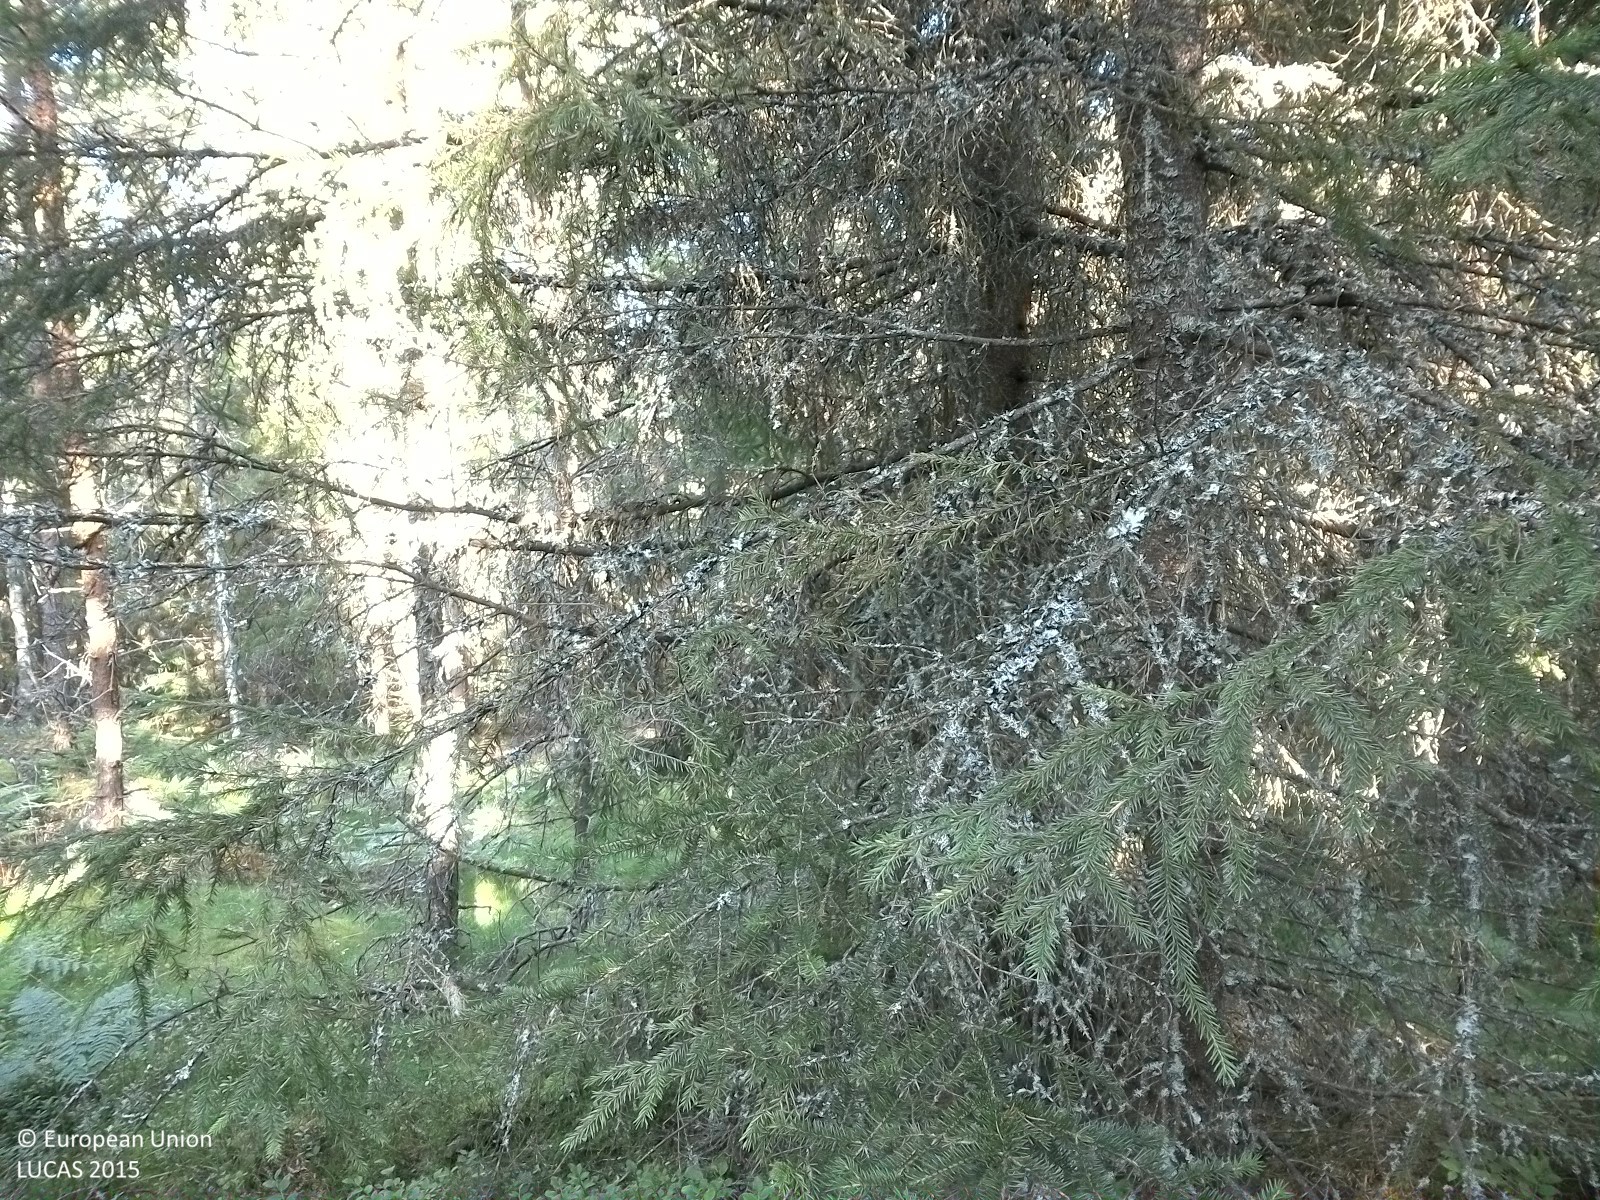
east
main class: Woodland
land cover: Other coniferous woodland
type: boreal forest
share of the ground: 25 - 50 %
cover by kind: herbaceous plants 45 %, coniferous forest trees 40 %, lichens and mosses 15 %
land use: Forestry
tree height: > 5 m
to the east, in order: Other coniferous woodland; Tracks; Spruce dominated coniferous woodland; Spruce dominated mixed woodland; Other coniferous woodland; Tracks; Spruce dominated coniferous woodland; Tracks; Pine dominated coniferous woodland; Tracks; Other coniferous woodland
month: August
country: SE
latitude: 59.2199
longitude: 14.6693
